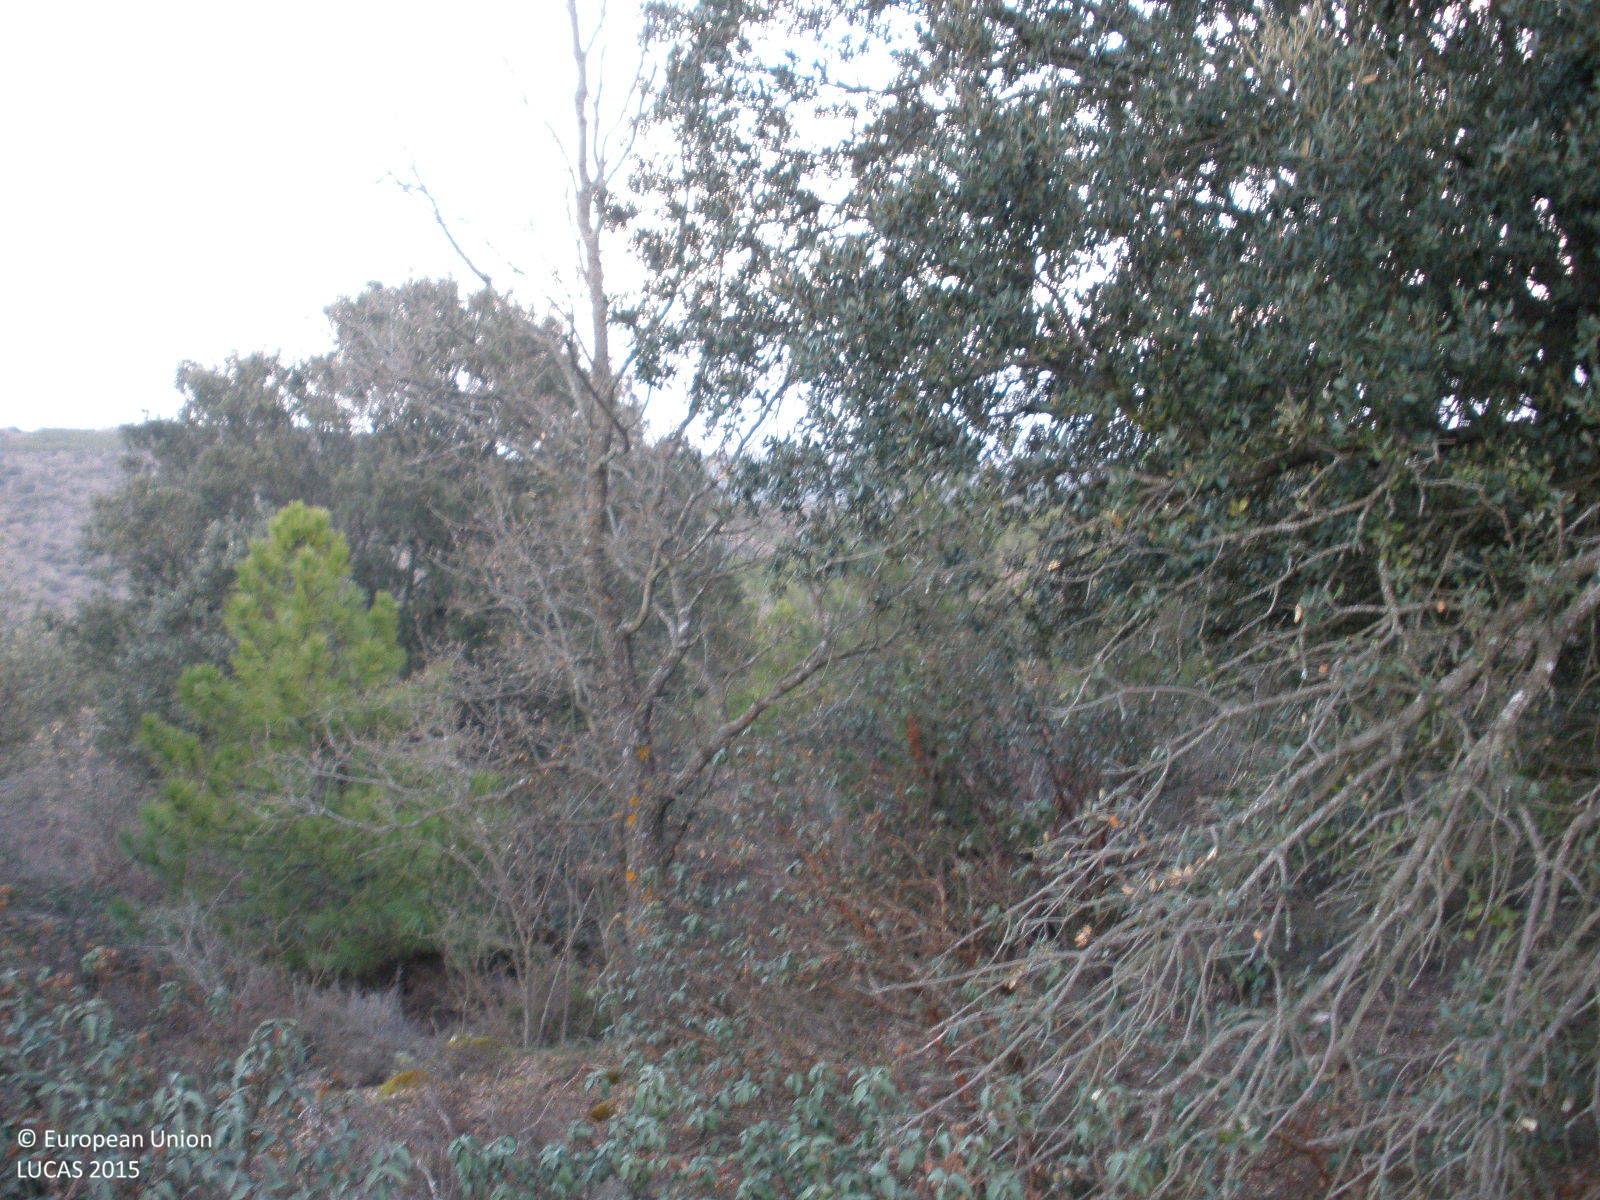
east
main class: Woodland
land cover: Other mixed woodland
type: coniferous forest of the mediterranean region
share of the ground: > 75 %
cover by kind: broadleaved forest trees 40 %, coniferous forest trees 30 %, shrubs 30 %
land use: Semi-natural and natural areas not in use
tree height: < 5 m
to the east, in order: Other mixed woodland; Paved roads, cycling and walking lanes; Other mixed woodland; Electric lines; Other mixed woodland
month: April
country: ES
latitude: 41.1042
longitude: -1.1759
